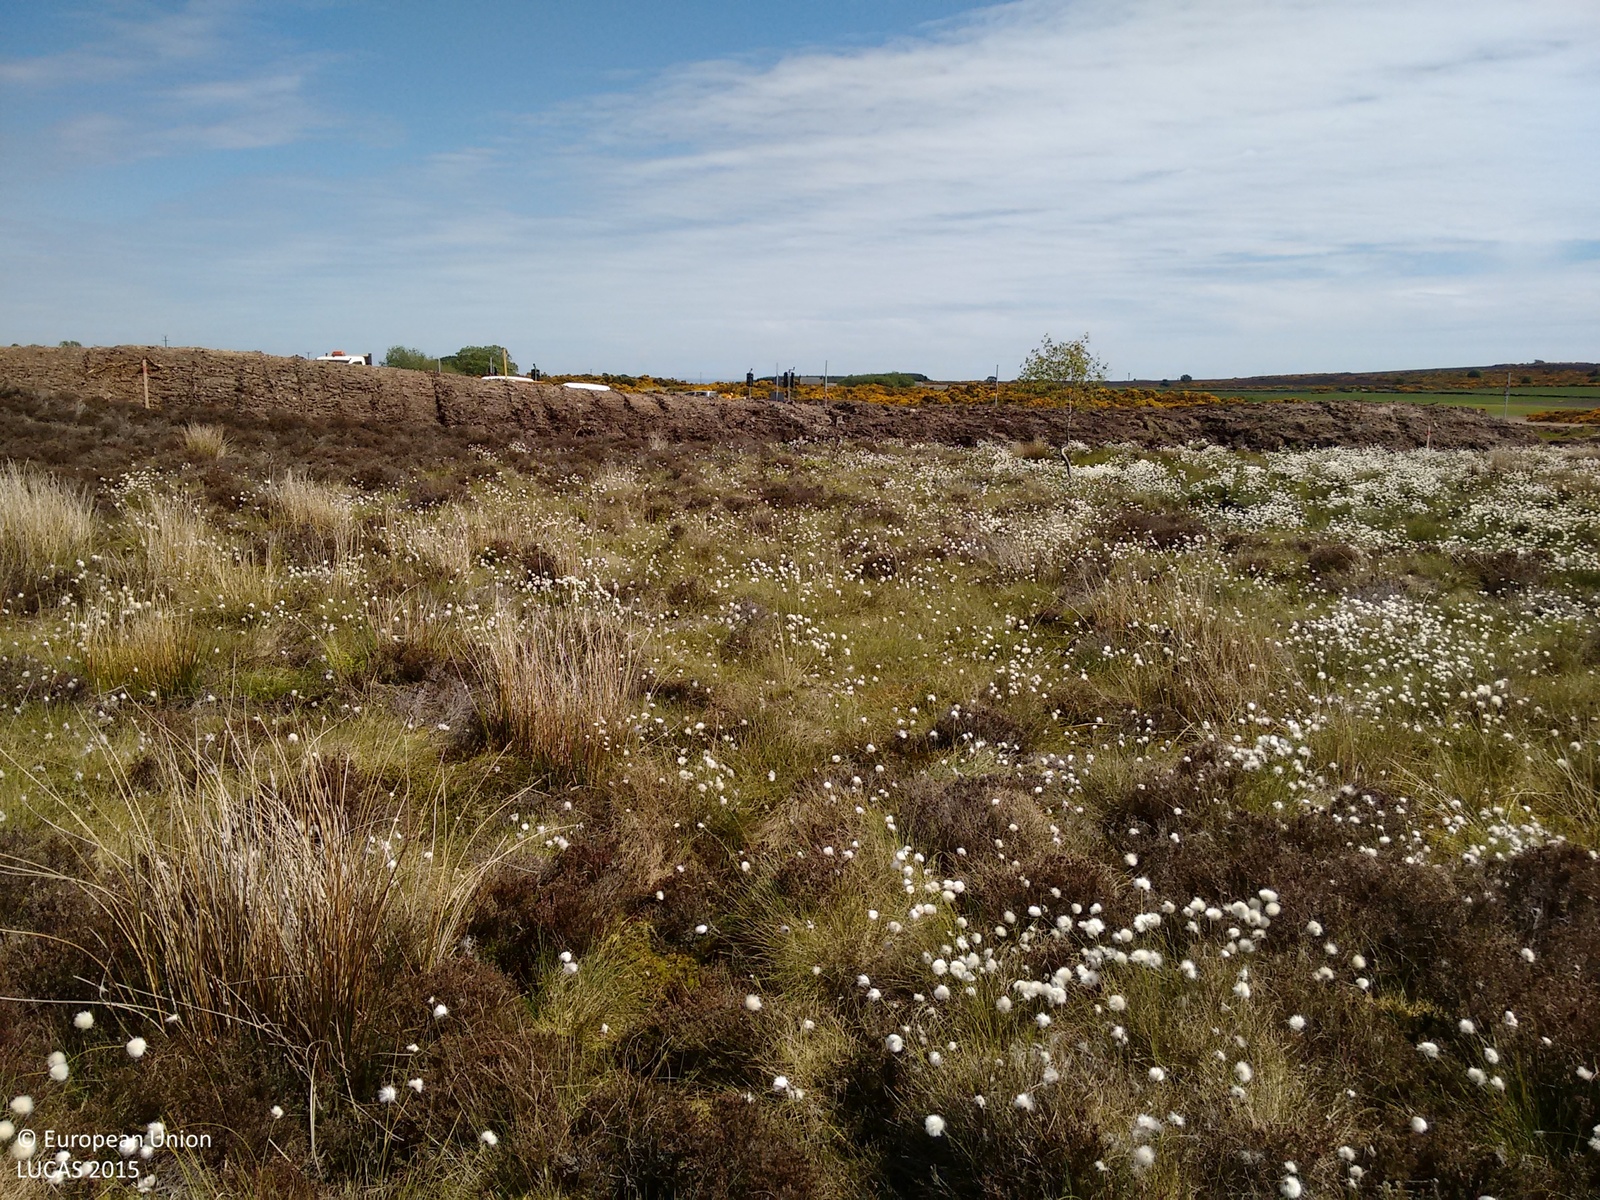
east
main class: Shrubland
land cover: Shrubland without tree cover
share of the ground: > 75 %
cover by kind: shrubs 65 %, herbaceous plants 20 %, lichens and mosses 15 %
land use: Semi-natural and natural areas not in use
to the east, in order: Shrubland without tree cover; Other bare soil; Paved roads, cycling and walking lanes; Other bare soil; Fences; Grassland without tree/shrub cover; Single bushes/trees; Spontaneously vegetated surfaces; Rivers and streams; Spontaneously vegetated surfaces; Shrubland without tree cover; Spontaneously vegetated surfaces; Shrubland without tree cover
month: June
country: GB
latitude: 57.0036
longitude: -2.2177
